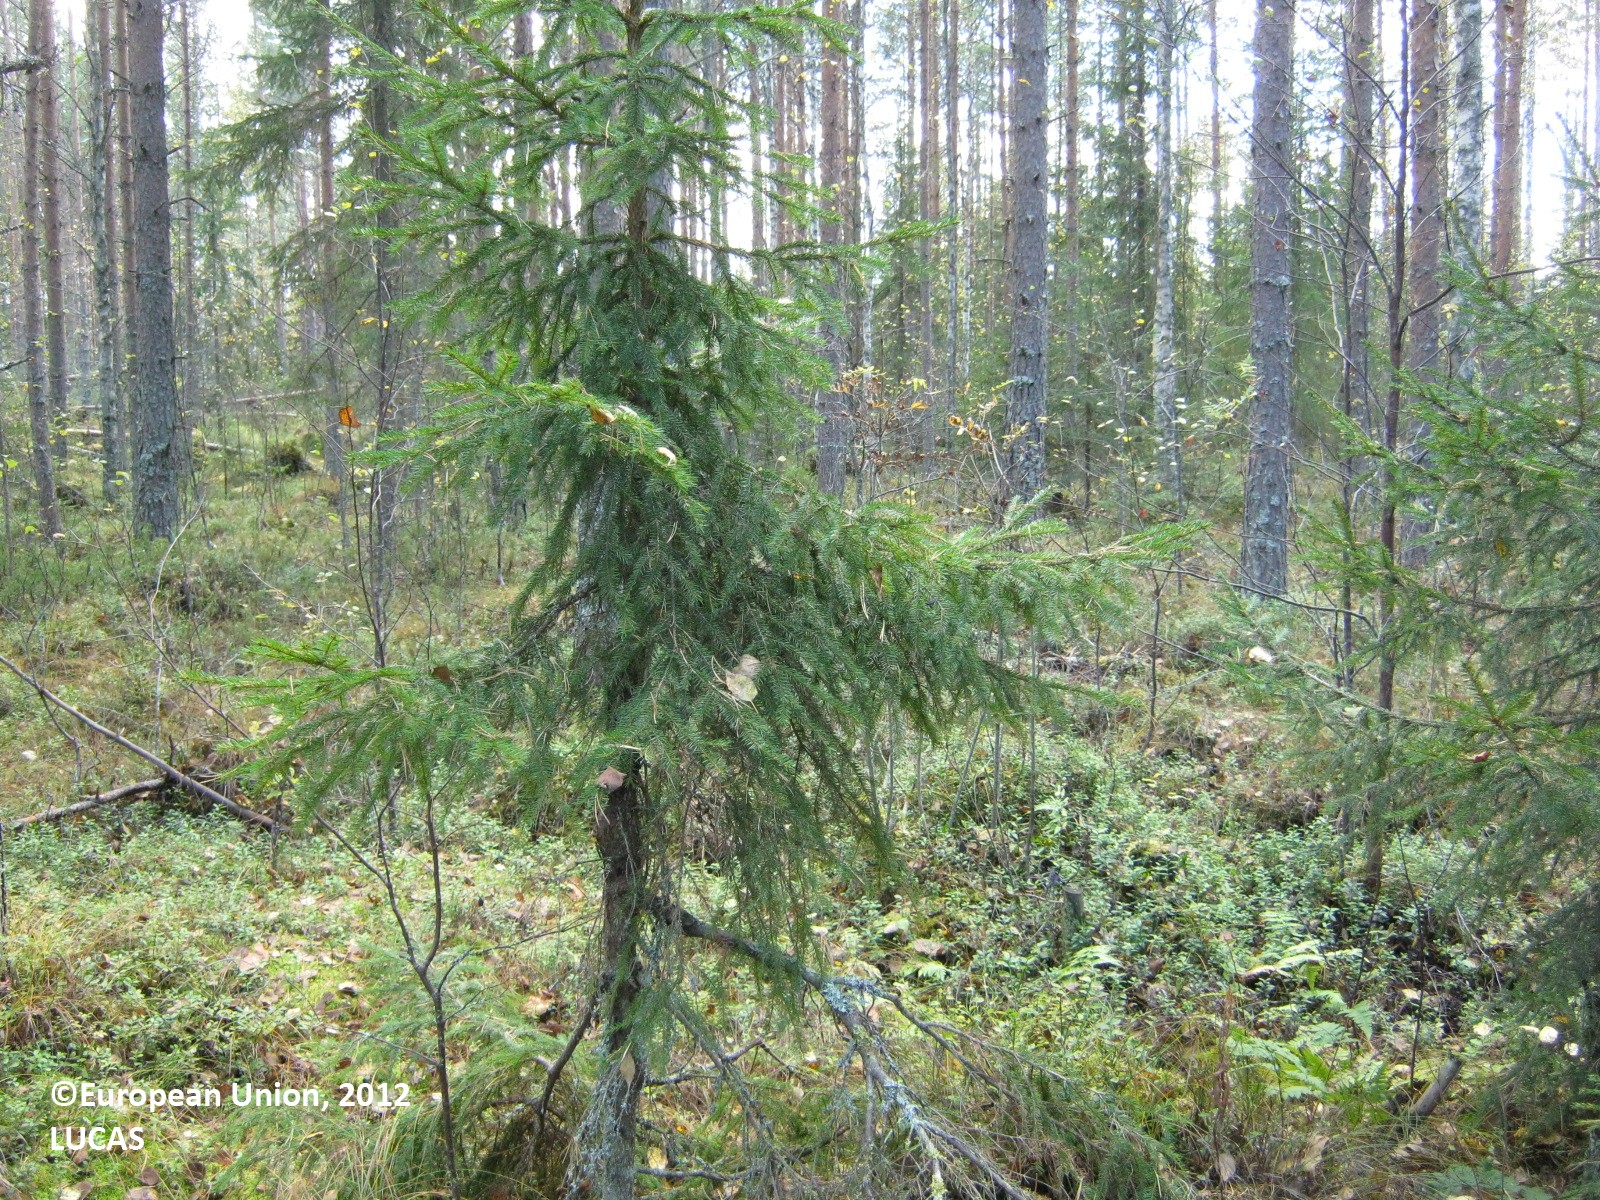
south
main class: Woodland
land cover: Pine dominated coniferous woodland
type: boreal forest
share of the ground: > 75 %
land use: Forestry
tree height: > 5 m
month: September
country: FI
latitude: 63.3545
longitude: 25.8404
